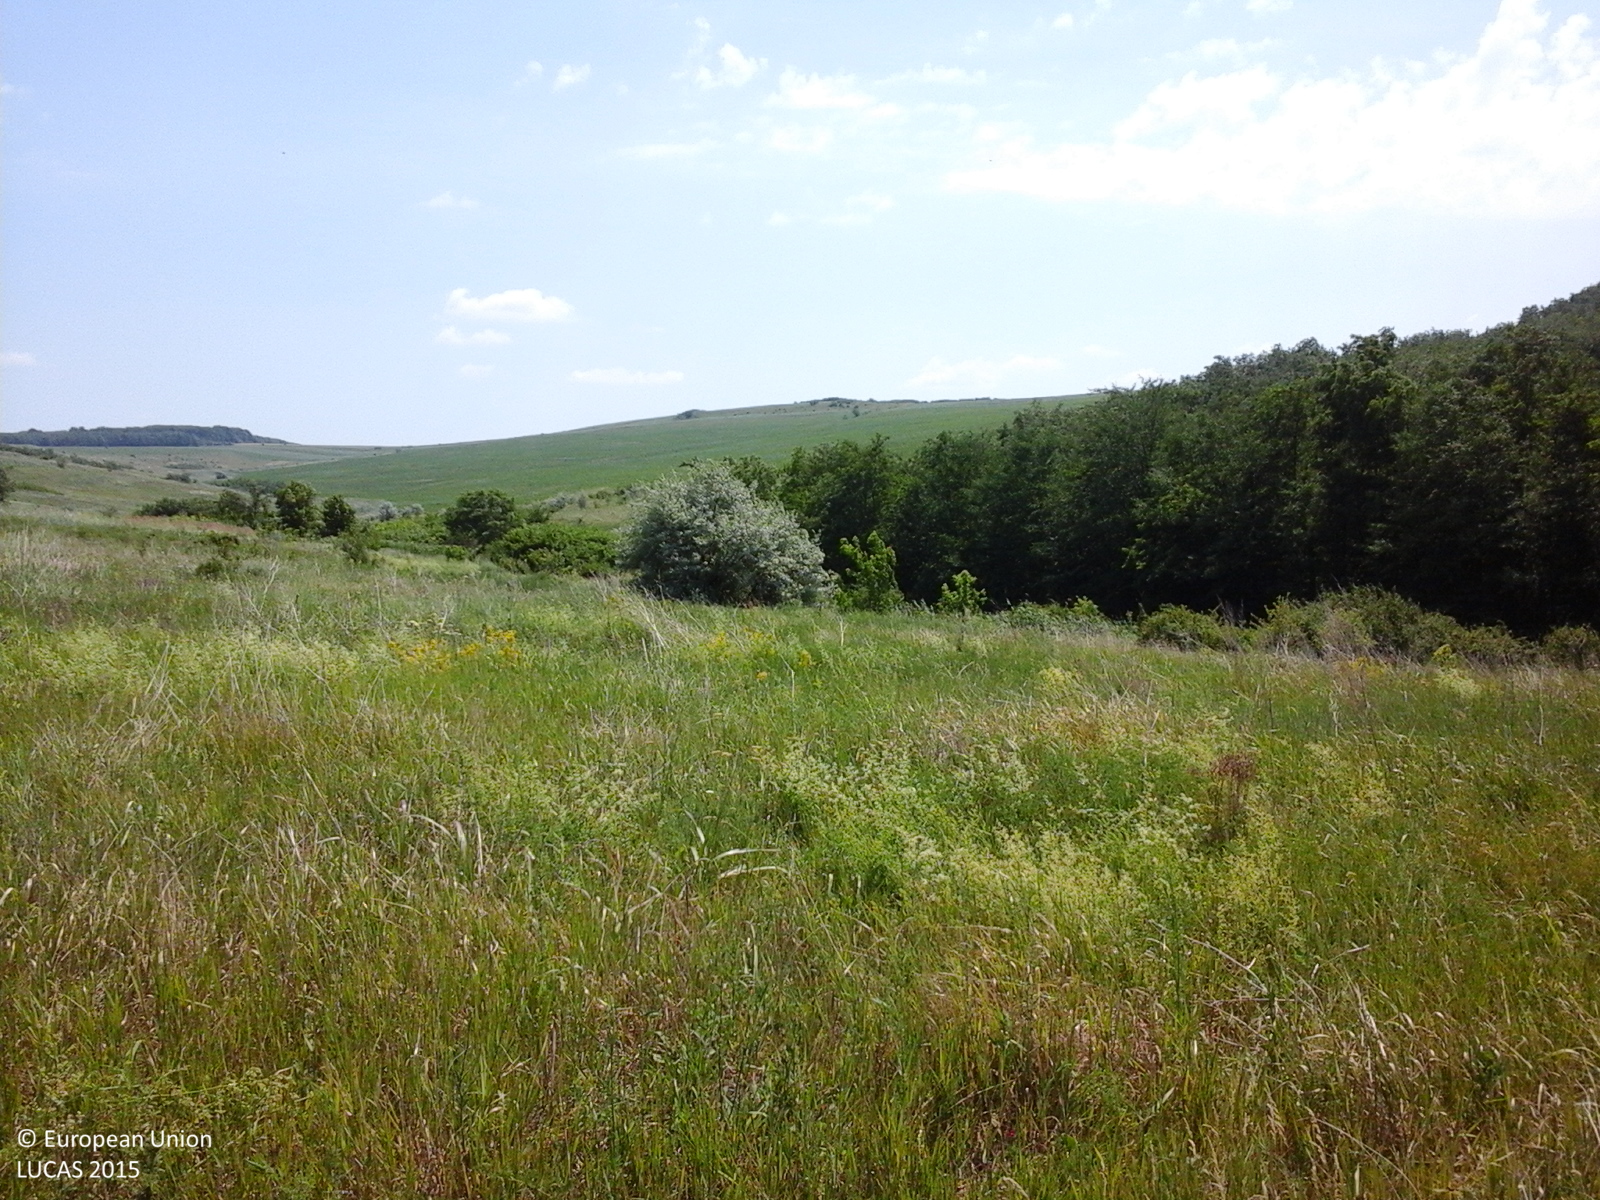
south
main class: Grassland
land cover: Grassland with sparse tree/shrub cover
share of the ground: > 75 %
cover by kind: herbaceous plants 90 %, broadleaved forest trees 5 %, shrubs 5 %
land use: Agriculture (excluding fallow land and kitchen gardens)
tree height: < 5 m
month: June
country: RO
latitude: 47.2441
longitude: 27.6526
